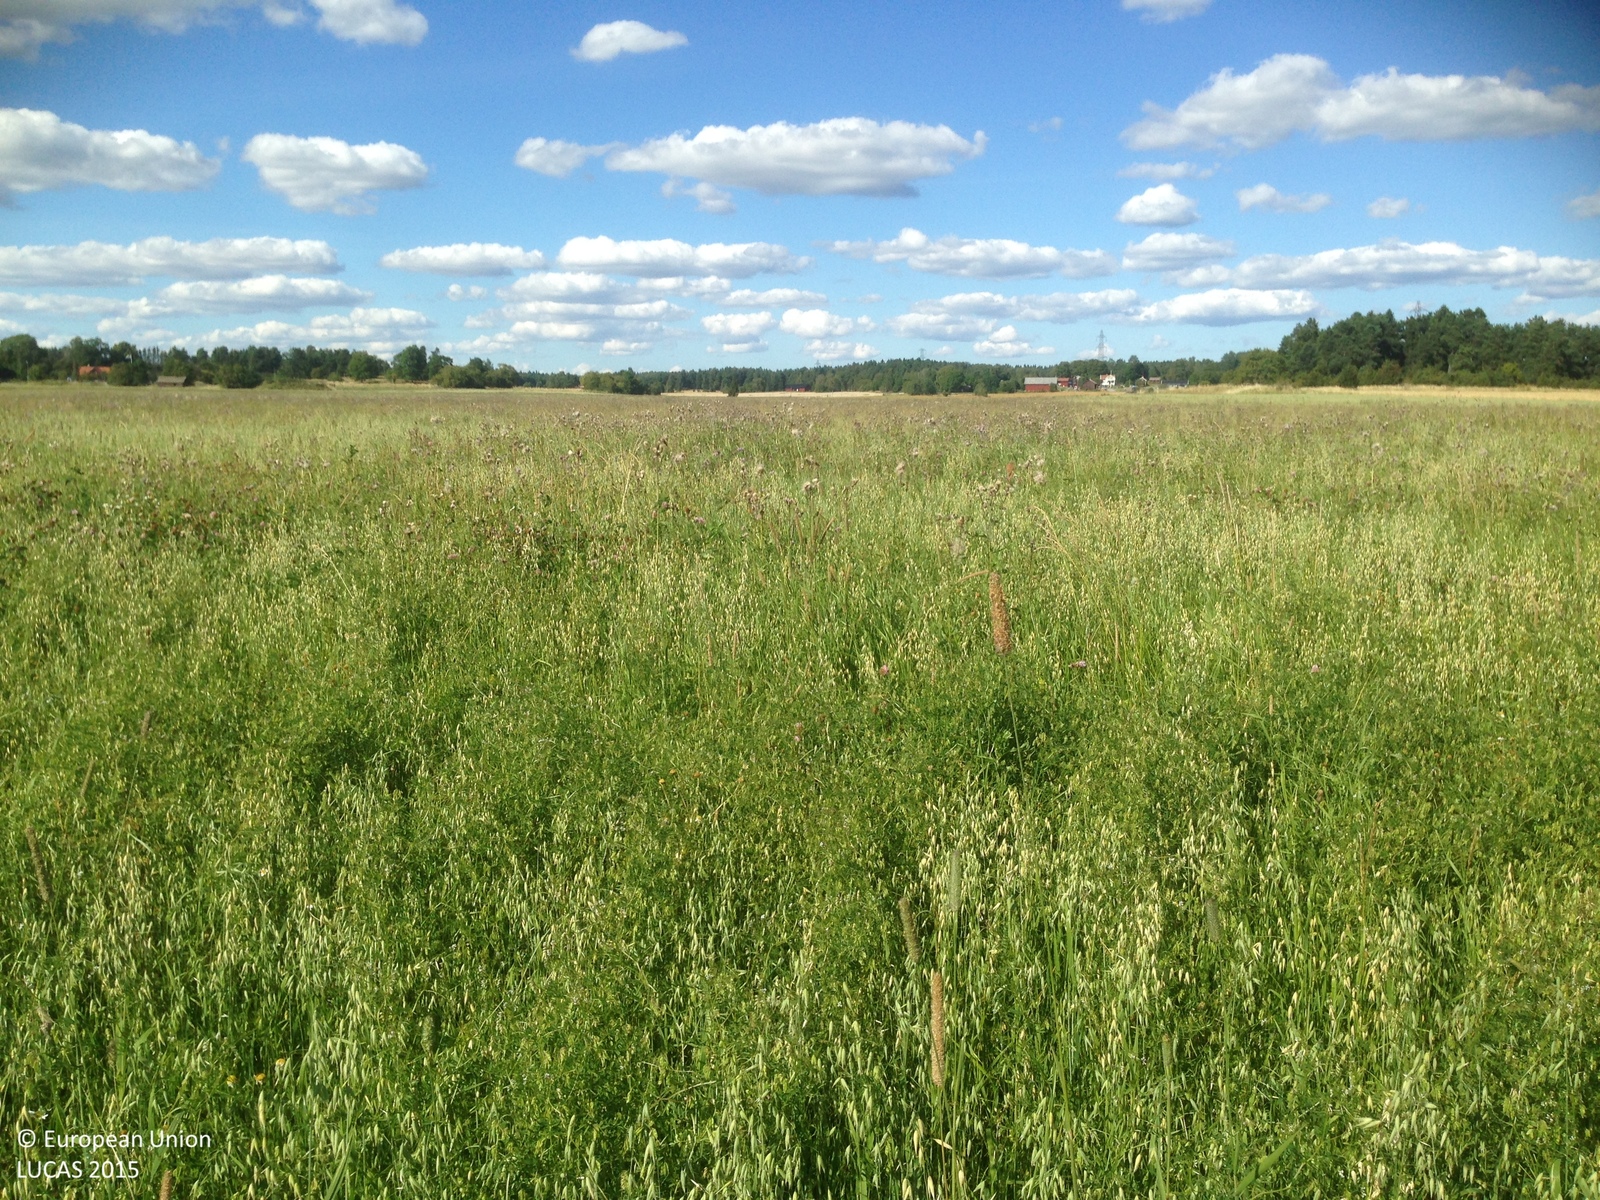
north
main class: Cropland
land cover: Oats
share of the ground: > 75 %
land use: Agriculture (excluding fallow land and kitchen gardens)
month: August
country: SE
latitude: 59.6538
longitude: 17.8573
